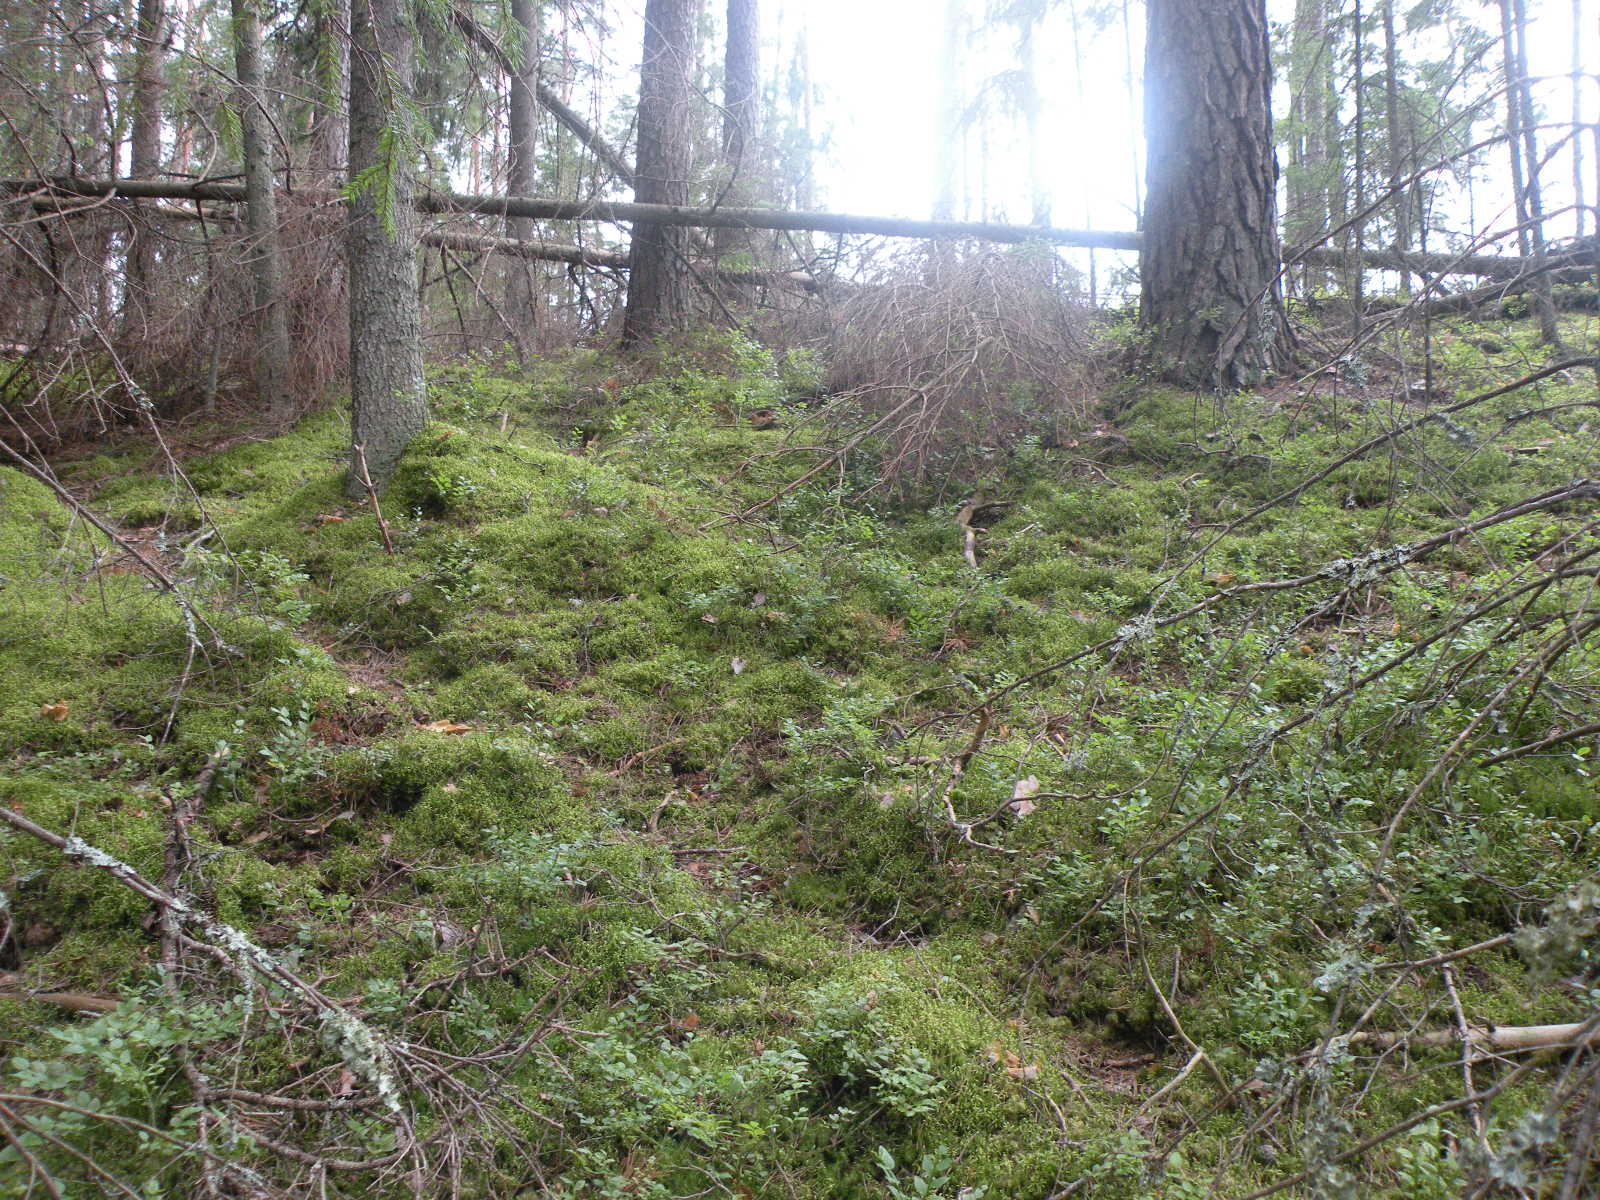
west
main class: Woodland
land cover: Other coniferous woodland
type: hemiboreal forest and nemoral coniferous forest and mixed broadleaved-coniferous forest
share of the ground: > 75 %
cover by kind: coniferous forest trees 80 %, lichens and mosses 10 %, shrubs 5 %, herbaceous plants 5 %
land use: Forestry
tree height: > 5 m
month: July
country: LV
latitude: 55.8323
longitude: 27.2740
